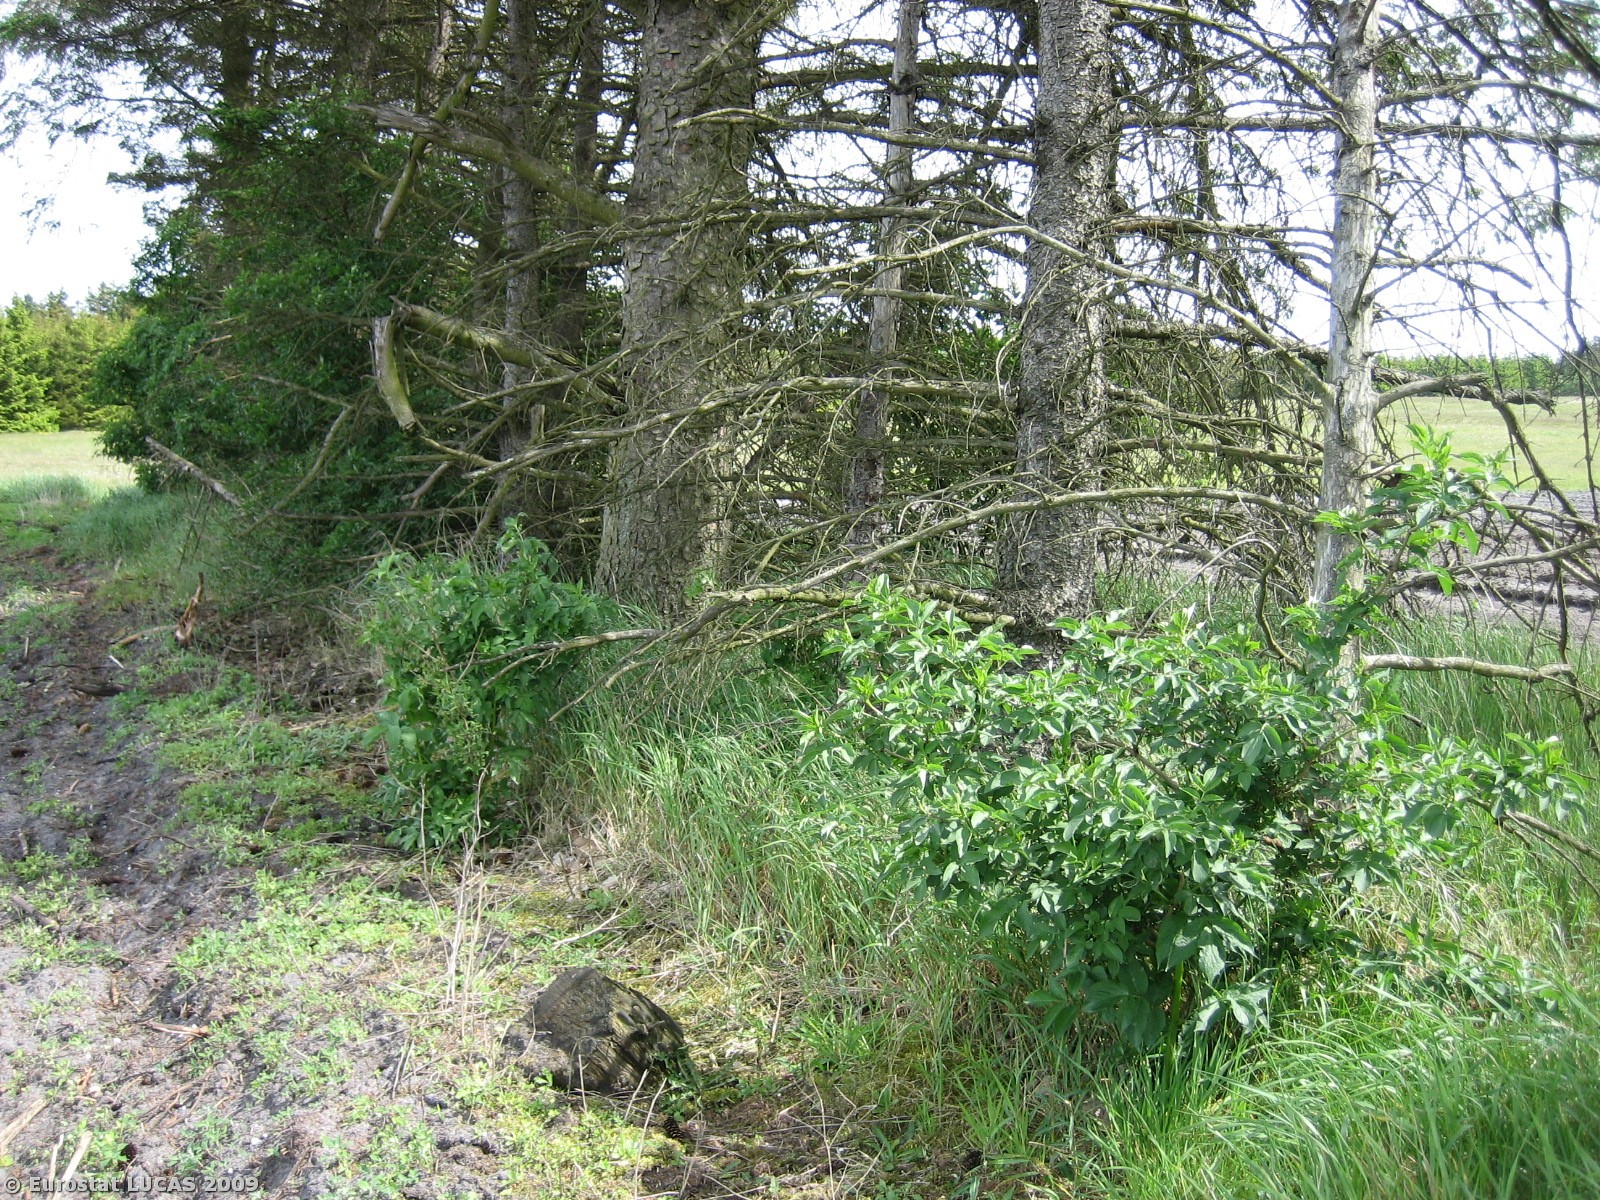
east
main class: Cropland
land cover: Maize
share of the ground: < 10 %
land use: Agriculture (excluding fallow land and kitchen gardens)
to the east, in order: Maize; Coniferous woodland; Potatoes; Tracks; Grassland without tree/shrub cover; Tracks; Grassland without tree/shrub cover; Coniferous woodland; Grass margins; Coniferous woodland; Grassland without tree/shrub cover; Coniferous woodland
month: May
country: DK
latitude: 56.2932
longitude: 9.2093
